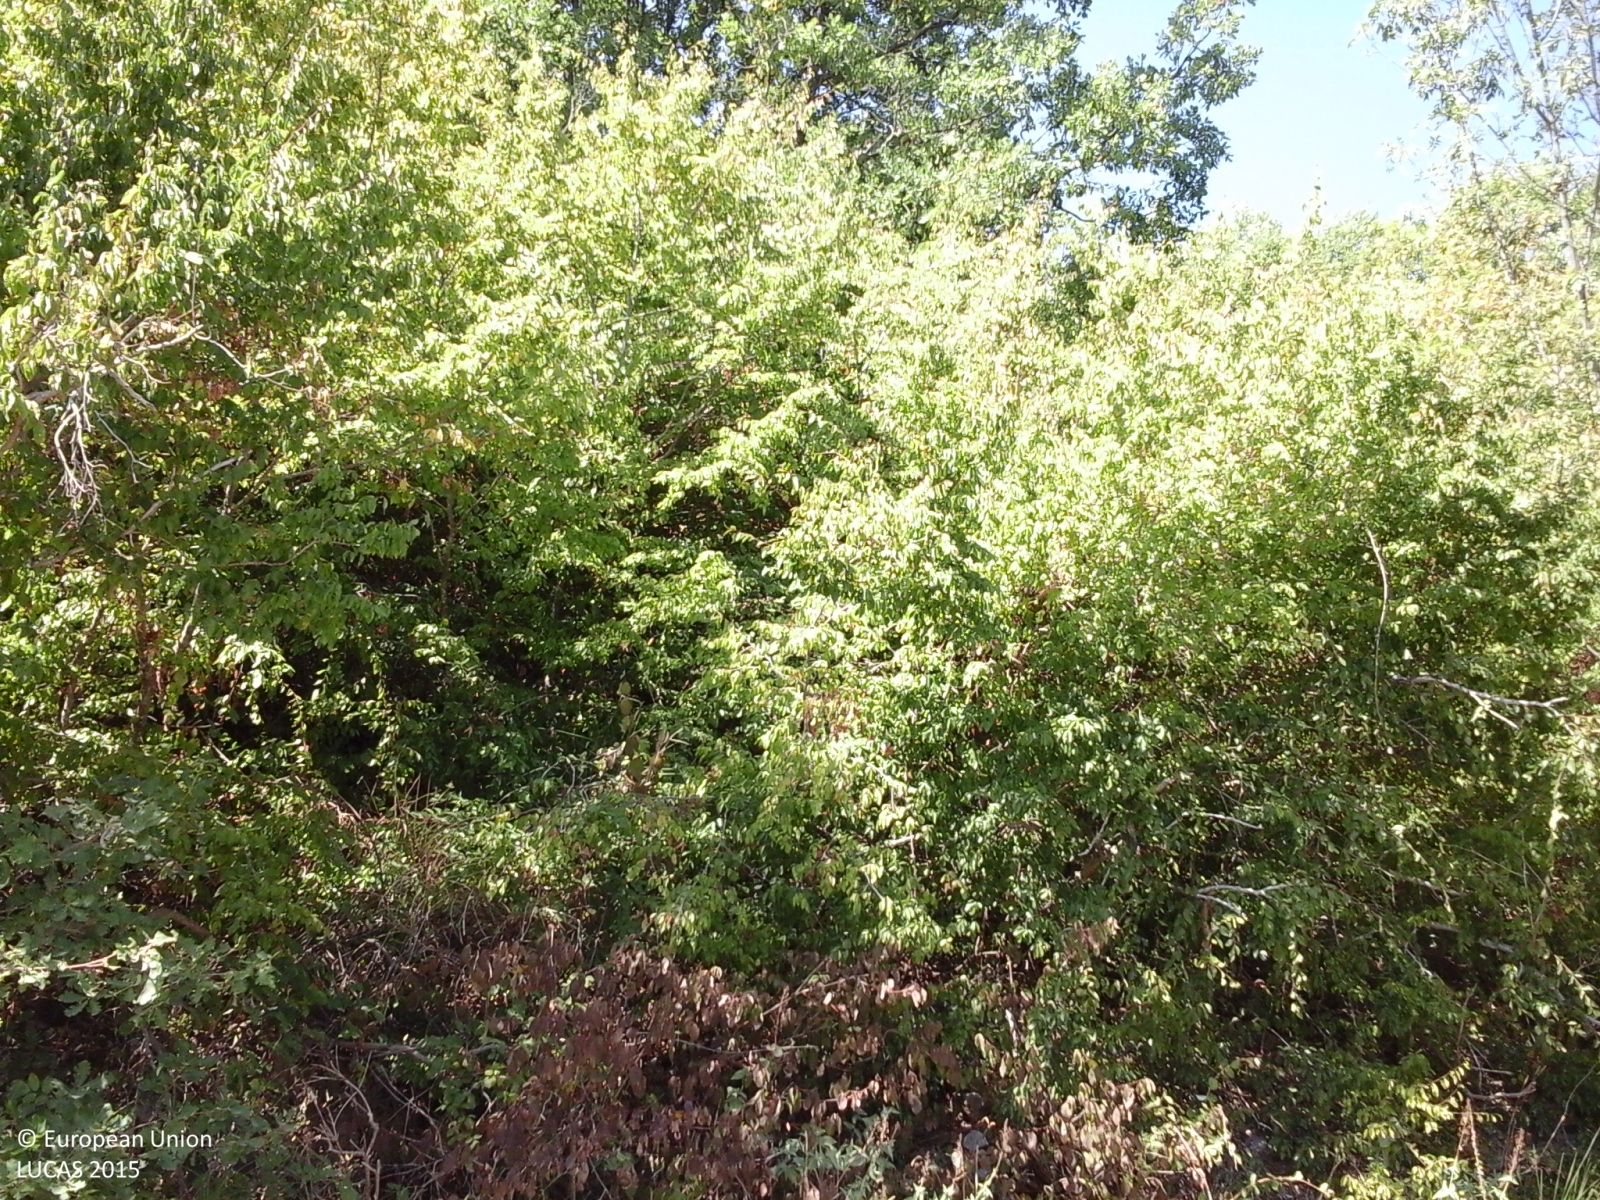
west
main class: Woodland
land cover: Broadleaved woodland
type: thermophilous deciduous forest
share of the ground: > 75 %
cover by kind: broadleaved forest trees 75 %, shrubs 15 %, herbaceous plants 10 %
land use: Semi-natural and natural areas not in use
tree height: > 5 m
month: September
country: IT
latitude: 41.6995
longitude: 14.1790
